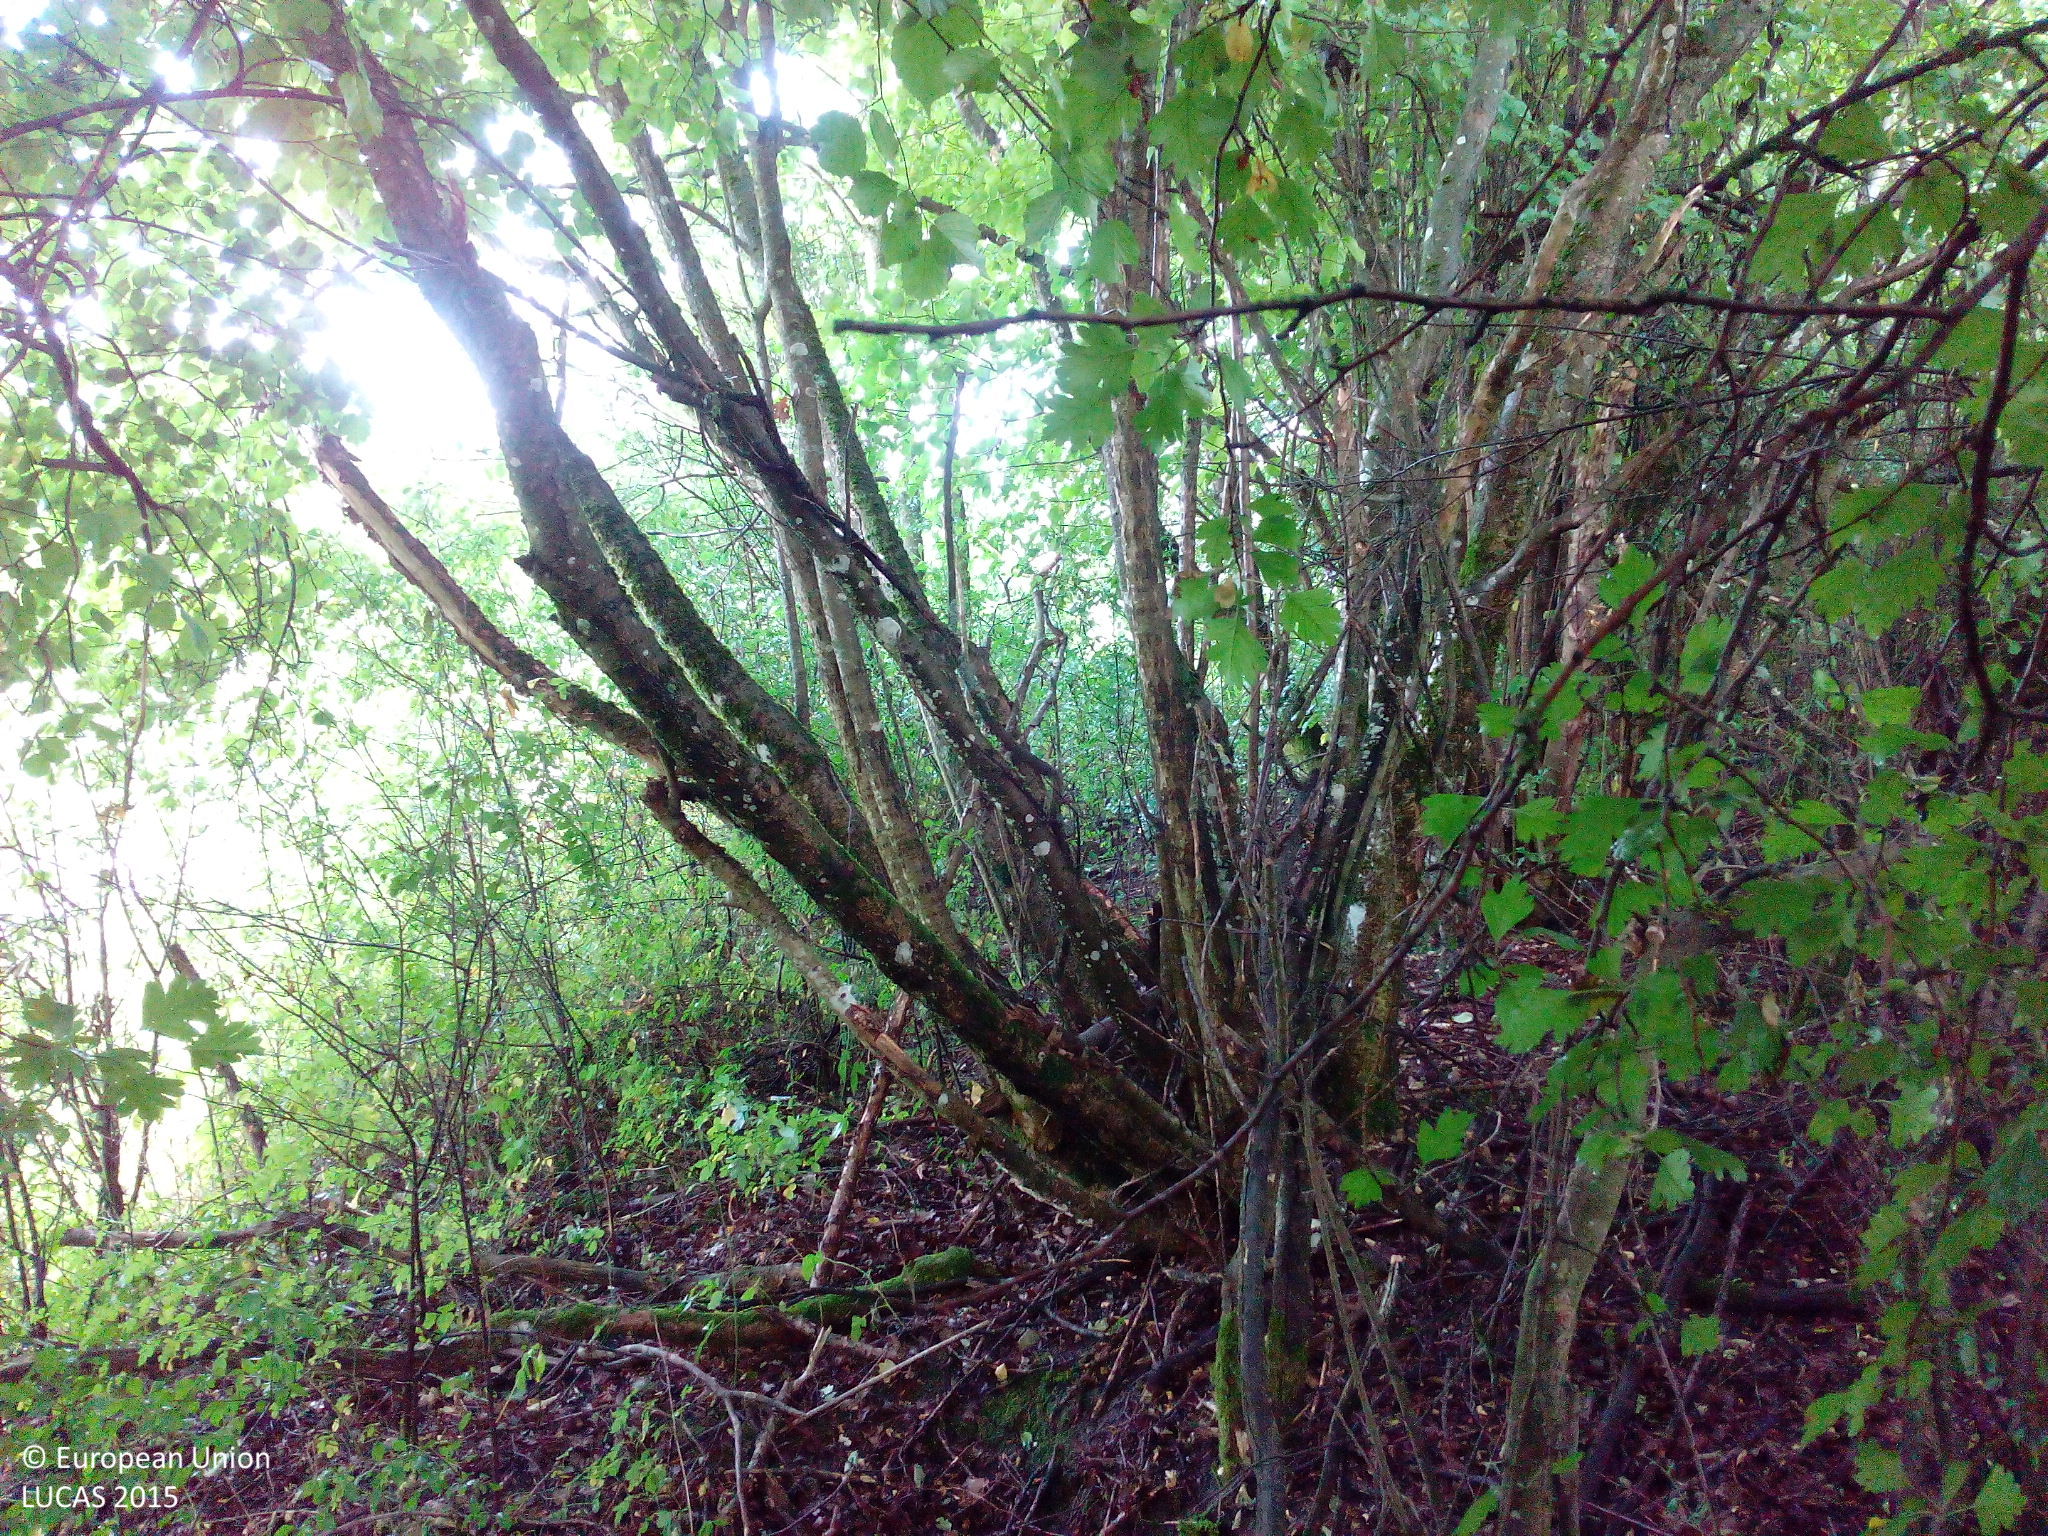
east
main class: Woodland
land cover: Broadleaved woodland
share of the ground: > 75 %
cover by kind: broadleaved forest trees 90 %, shrubs 10 %
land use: Semi-natural and natural areas not in use
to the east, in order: Broadleaved woodland; Grass margins; Paved roads, cycling and walking lanes; Grassland without tree/shrub cover
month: July
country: DE
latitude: 49.0147
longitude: 9.6857
